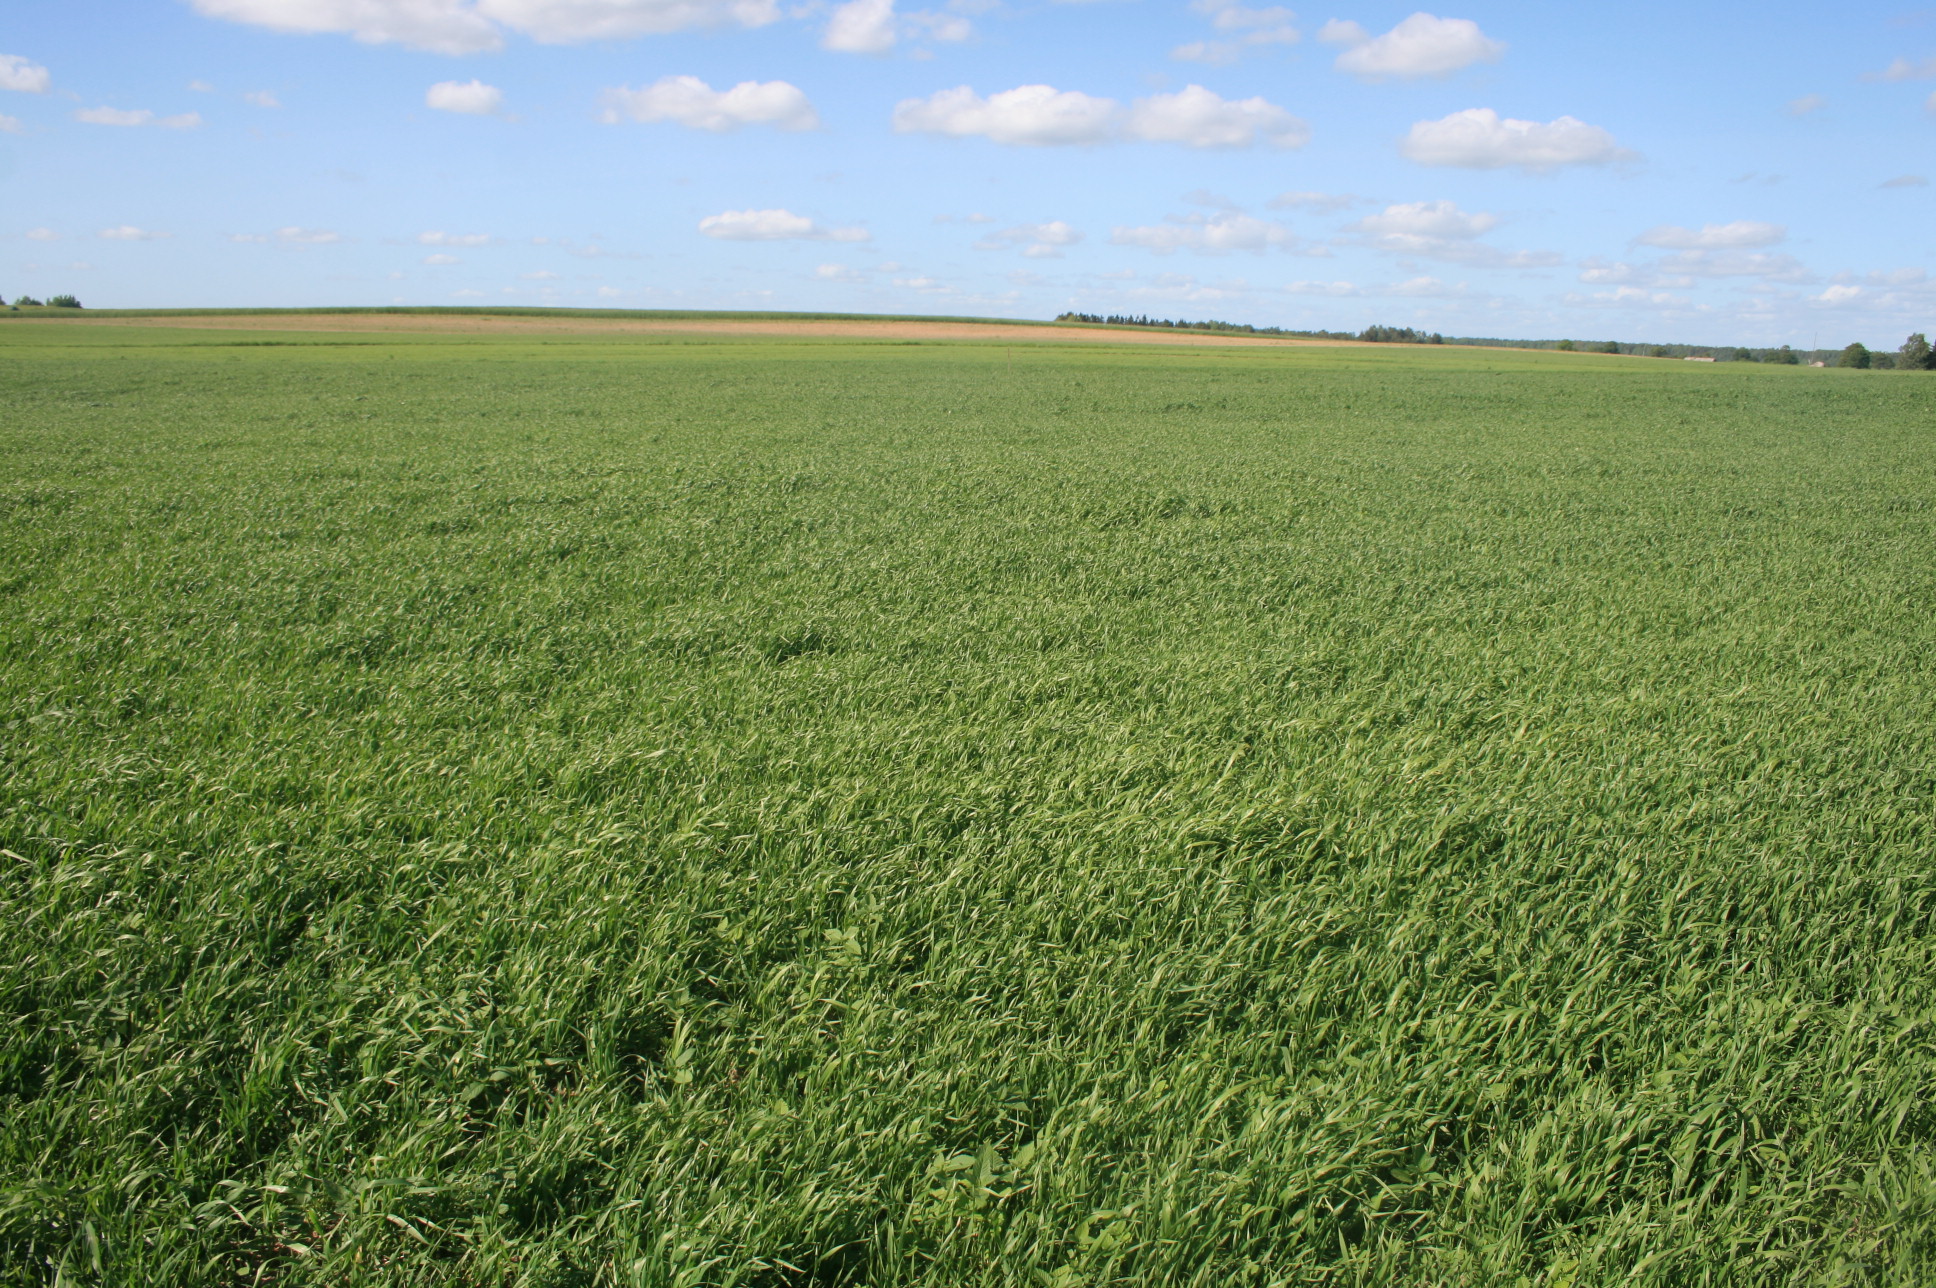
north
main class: Cropland
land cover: Common wheat
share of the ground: > 75 %
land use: Agriculture (excluding fallow land and kitchen gardens)
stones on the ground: < 10 %
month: June
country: LT
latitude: 56.0242
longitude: 22.3632
